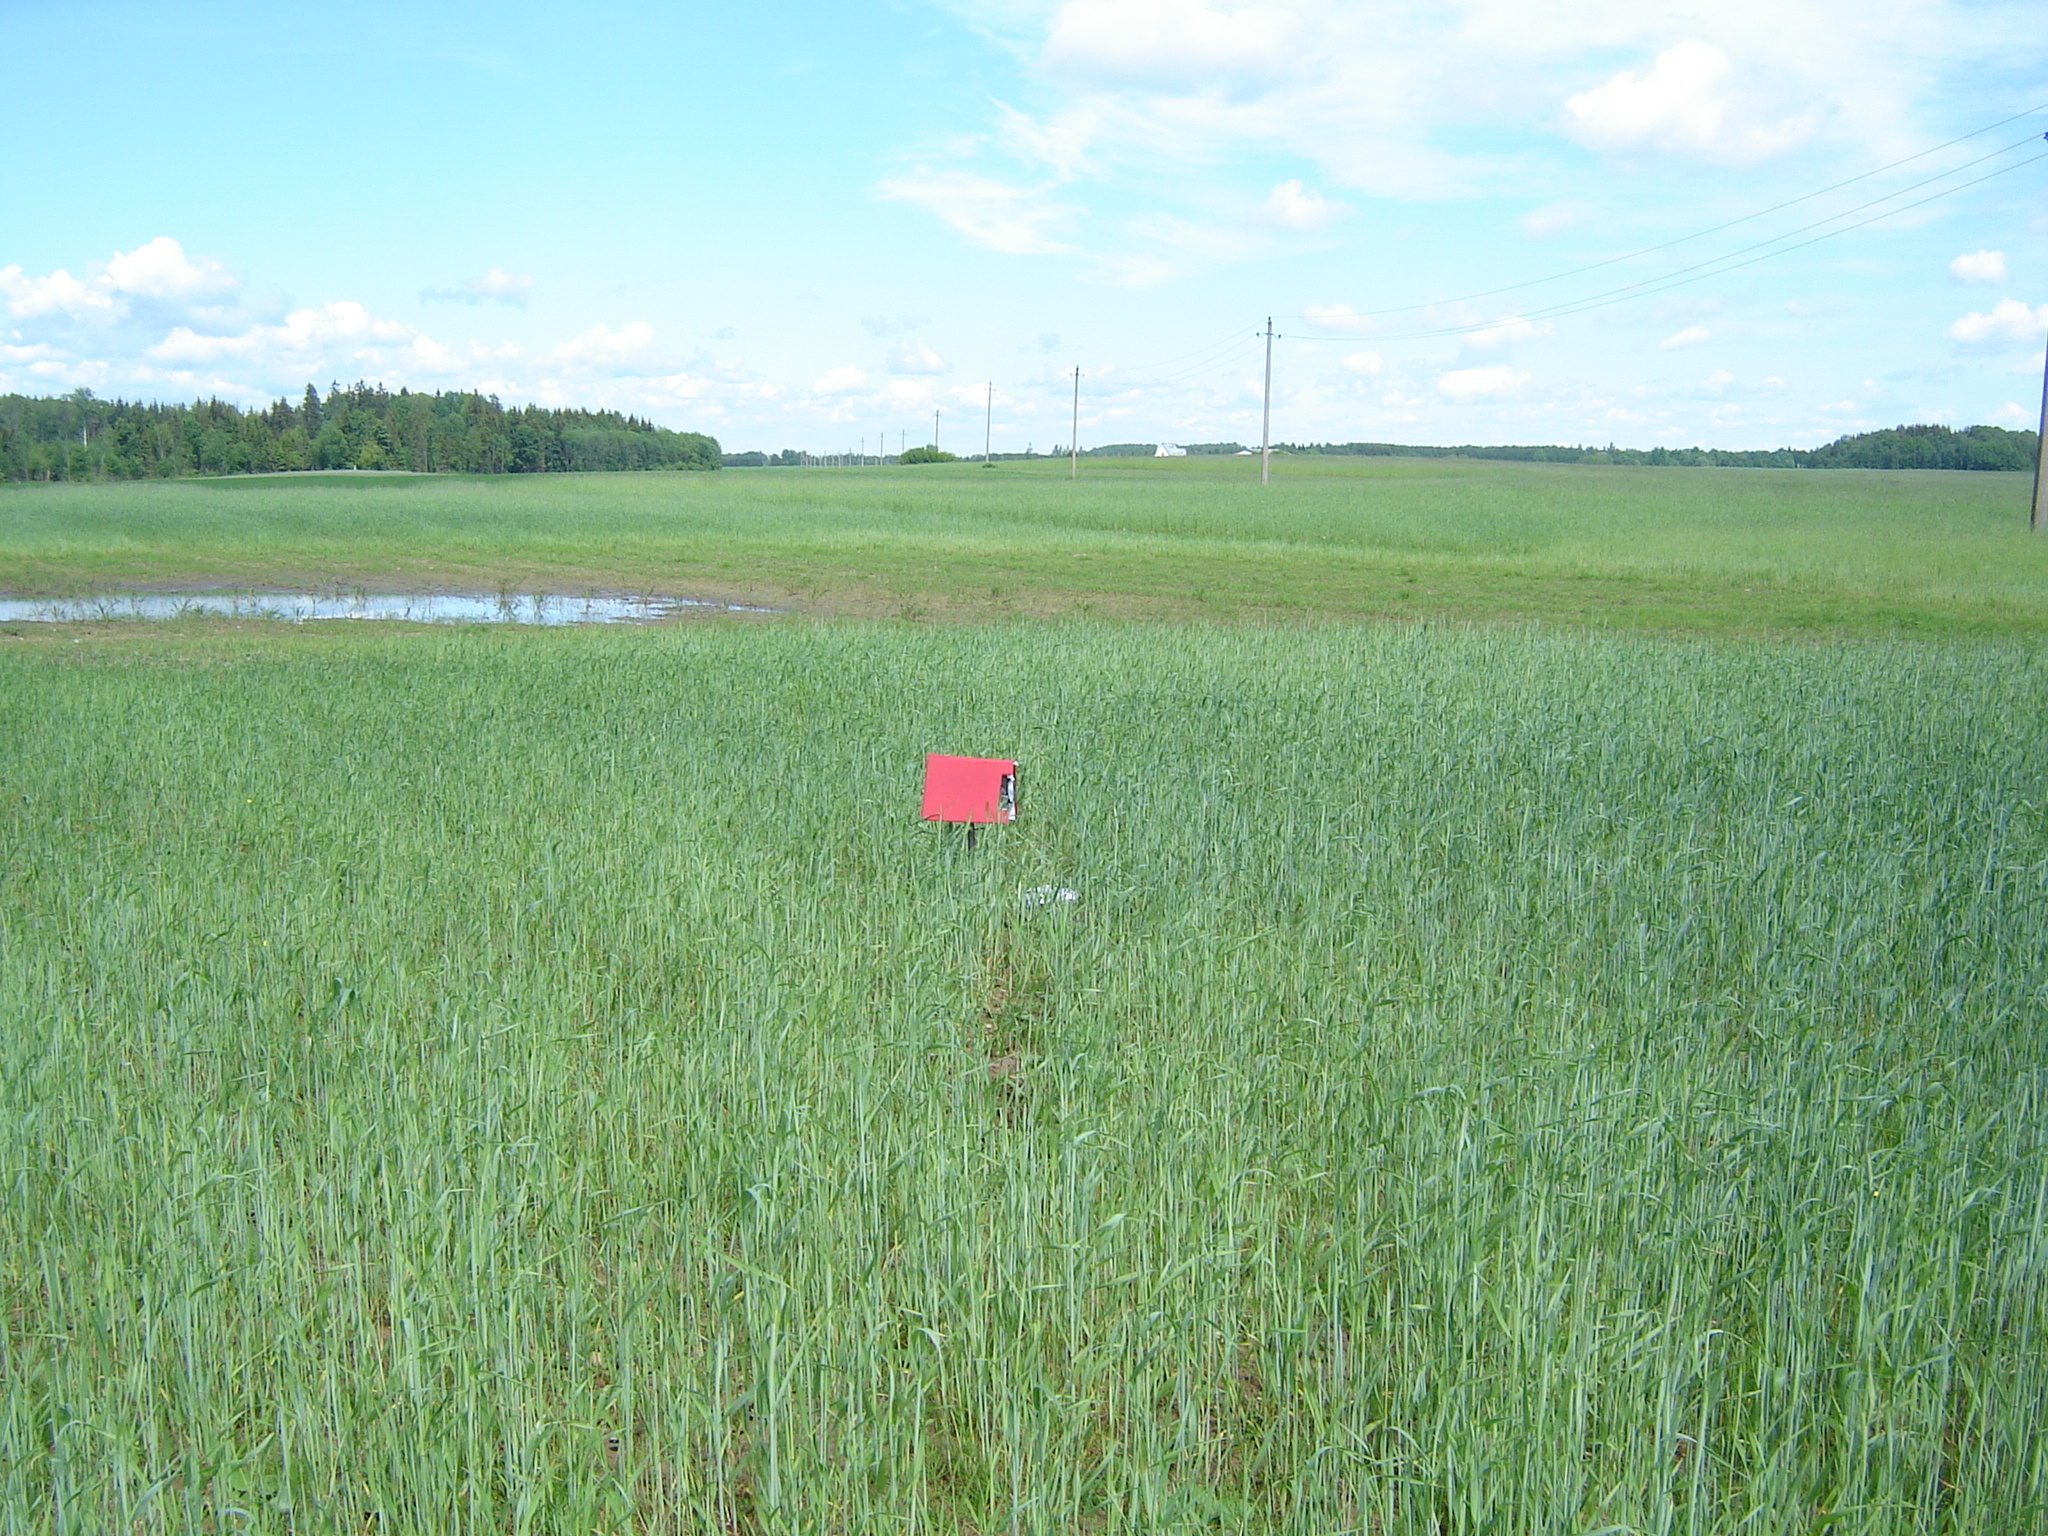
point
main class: Cropland
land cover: Rye
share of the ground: > 75 %
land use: Agriculture (excluding fallow land and kitchen gardens)
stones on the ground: < 10 %
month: May
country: LT
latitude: 55.7933
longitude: 25.1550
